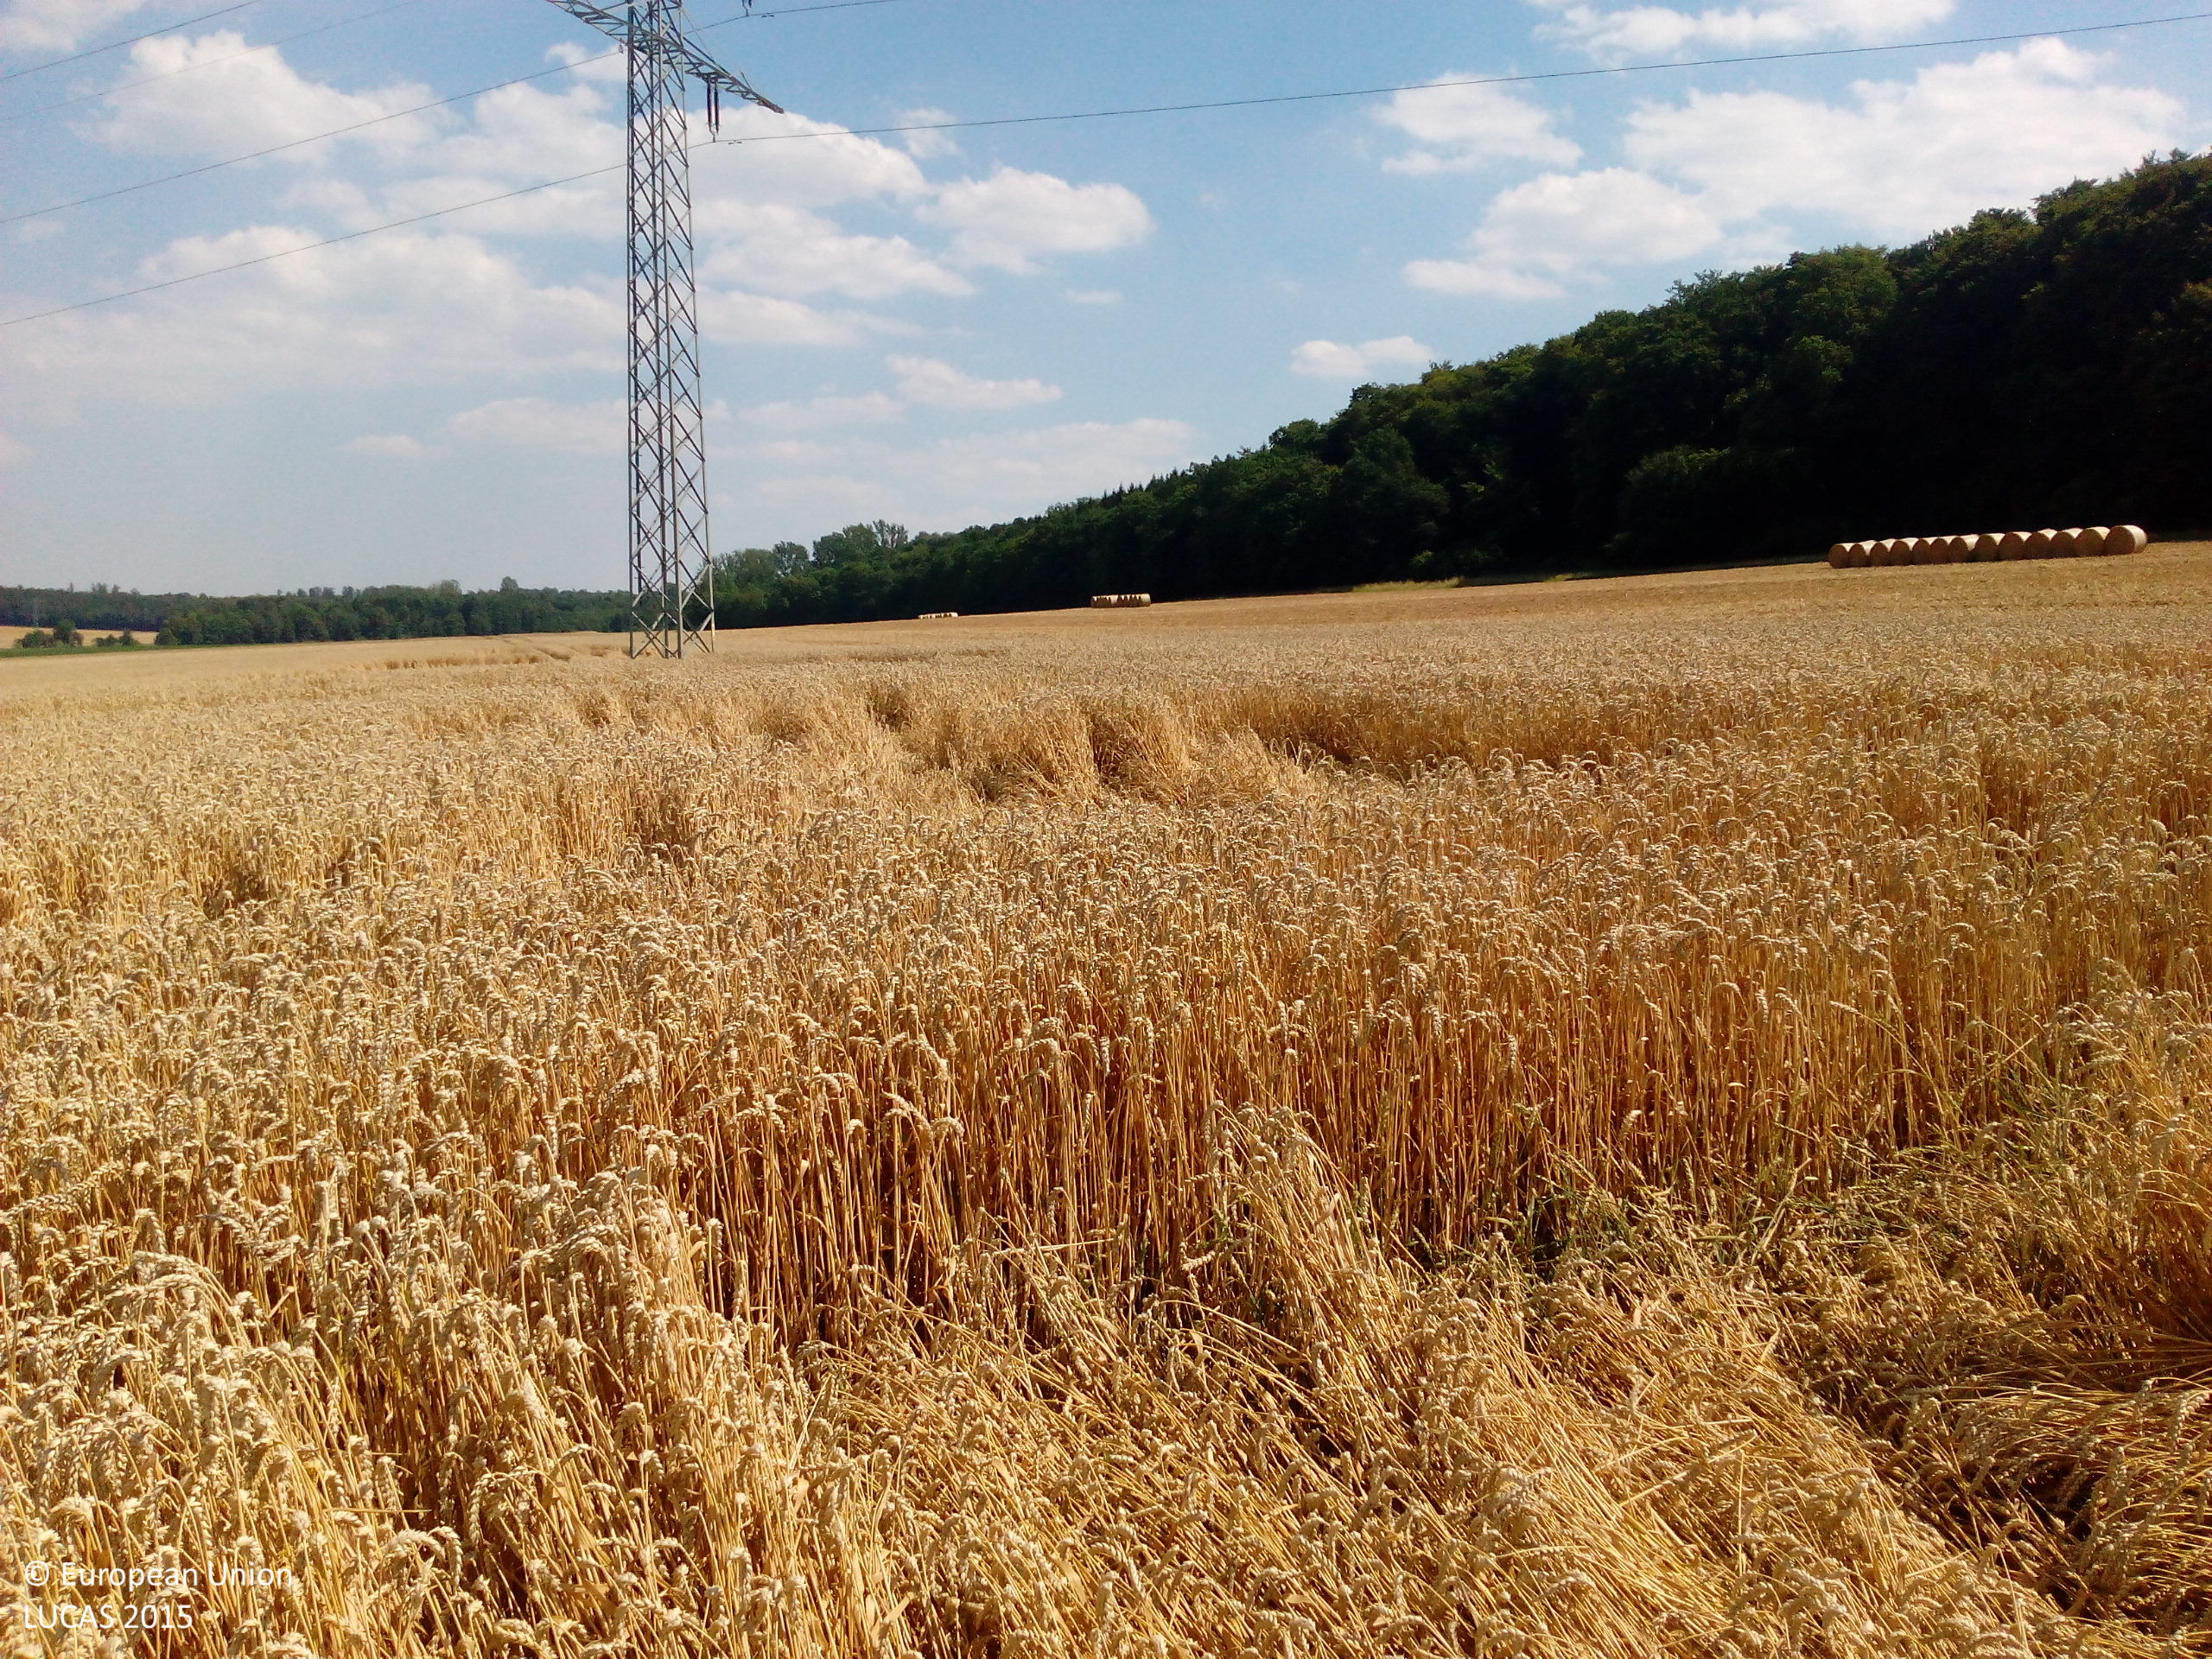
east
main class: Cropland
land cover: Common wheat
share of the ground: > 75 %
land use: Agriculture (excluding fallow land and kitchen gardens)
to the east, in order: Common wheat; Electric lines; Barley
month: August
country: DE
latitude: 52.1075
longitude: 10.2773
